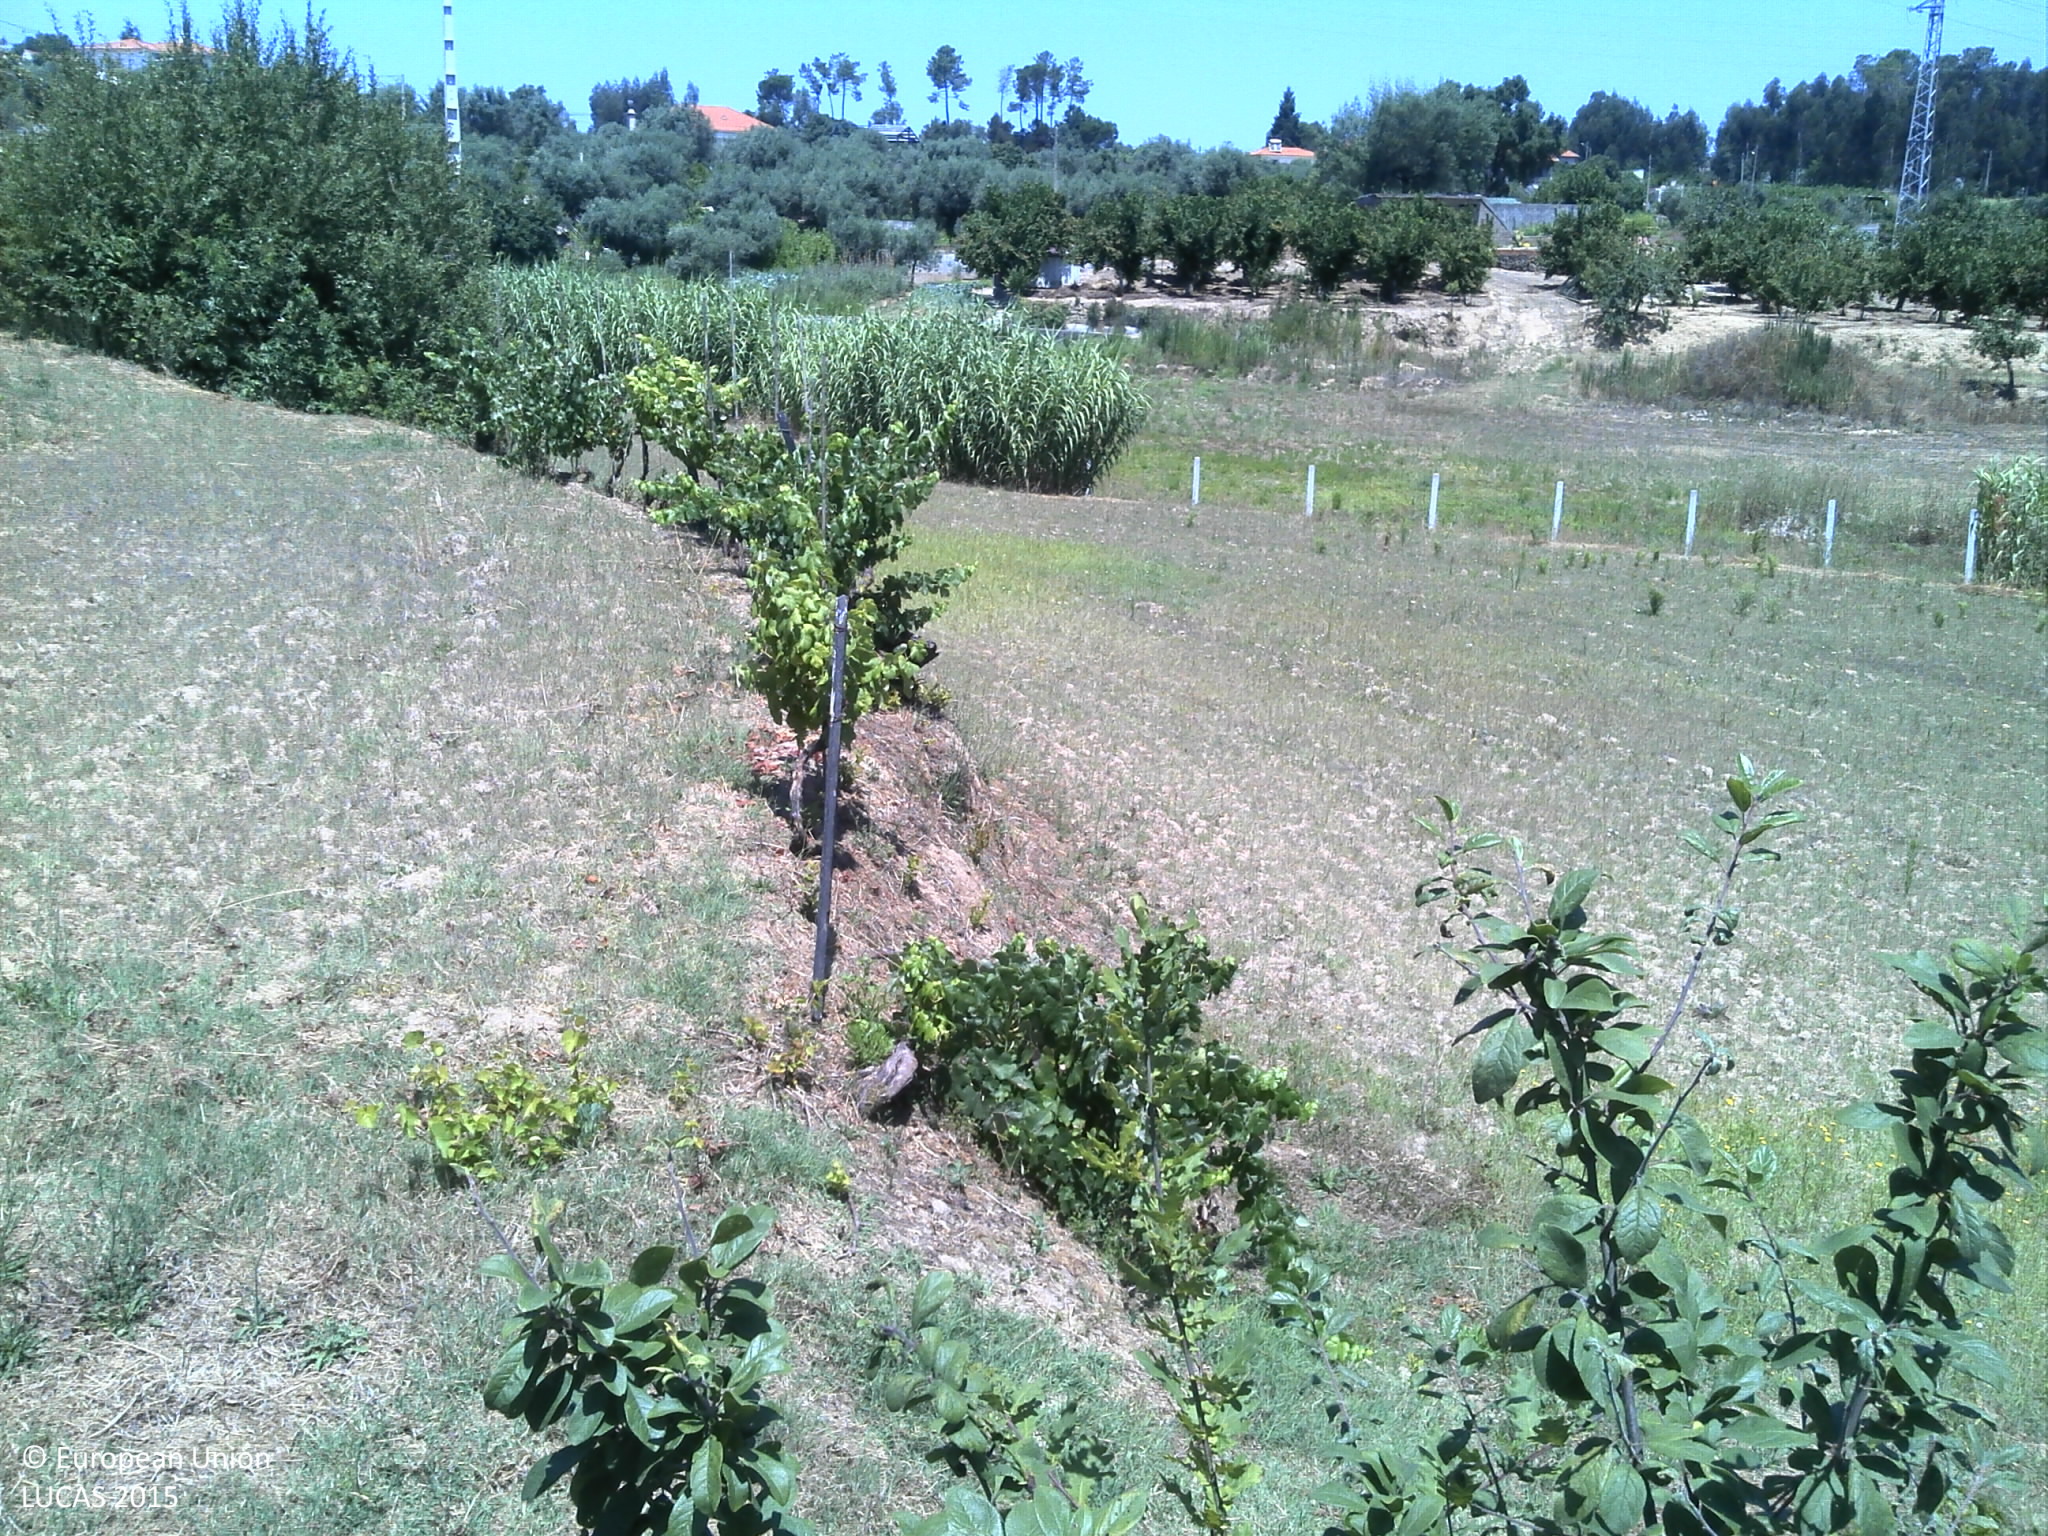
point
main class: Cropland
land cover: Vineyards
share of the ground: < 10 %
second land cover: Grassland without tree/shrub cover
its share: 25 - 50 %
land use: Agriculture (excluding fallow land and kitchen gardens)
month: July
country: PT
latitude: 40.4380
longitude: -7.9826
